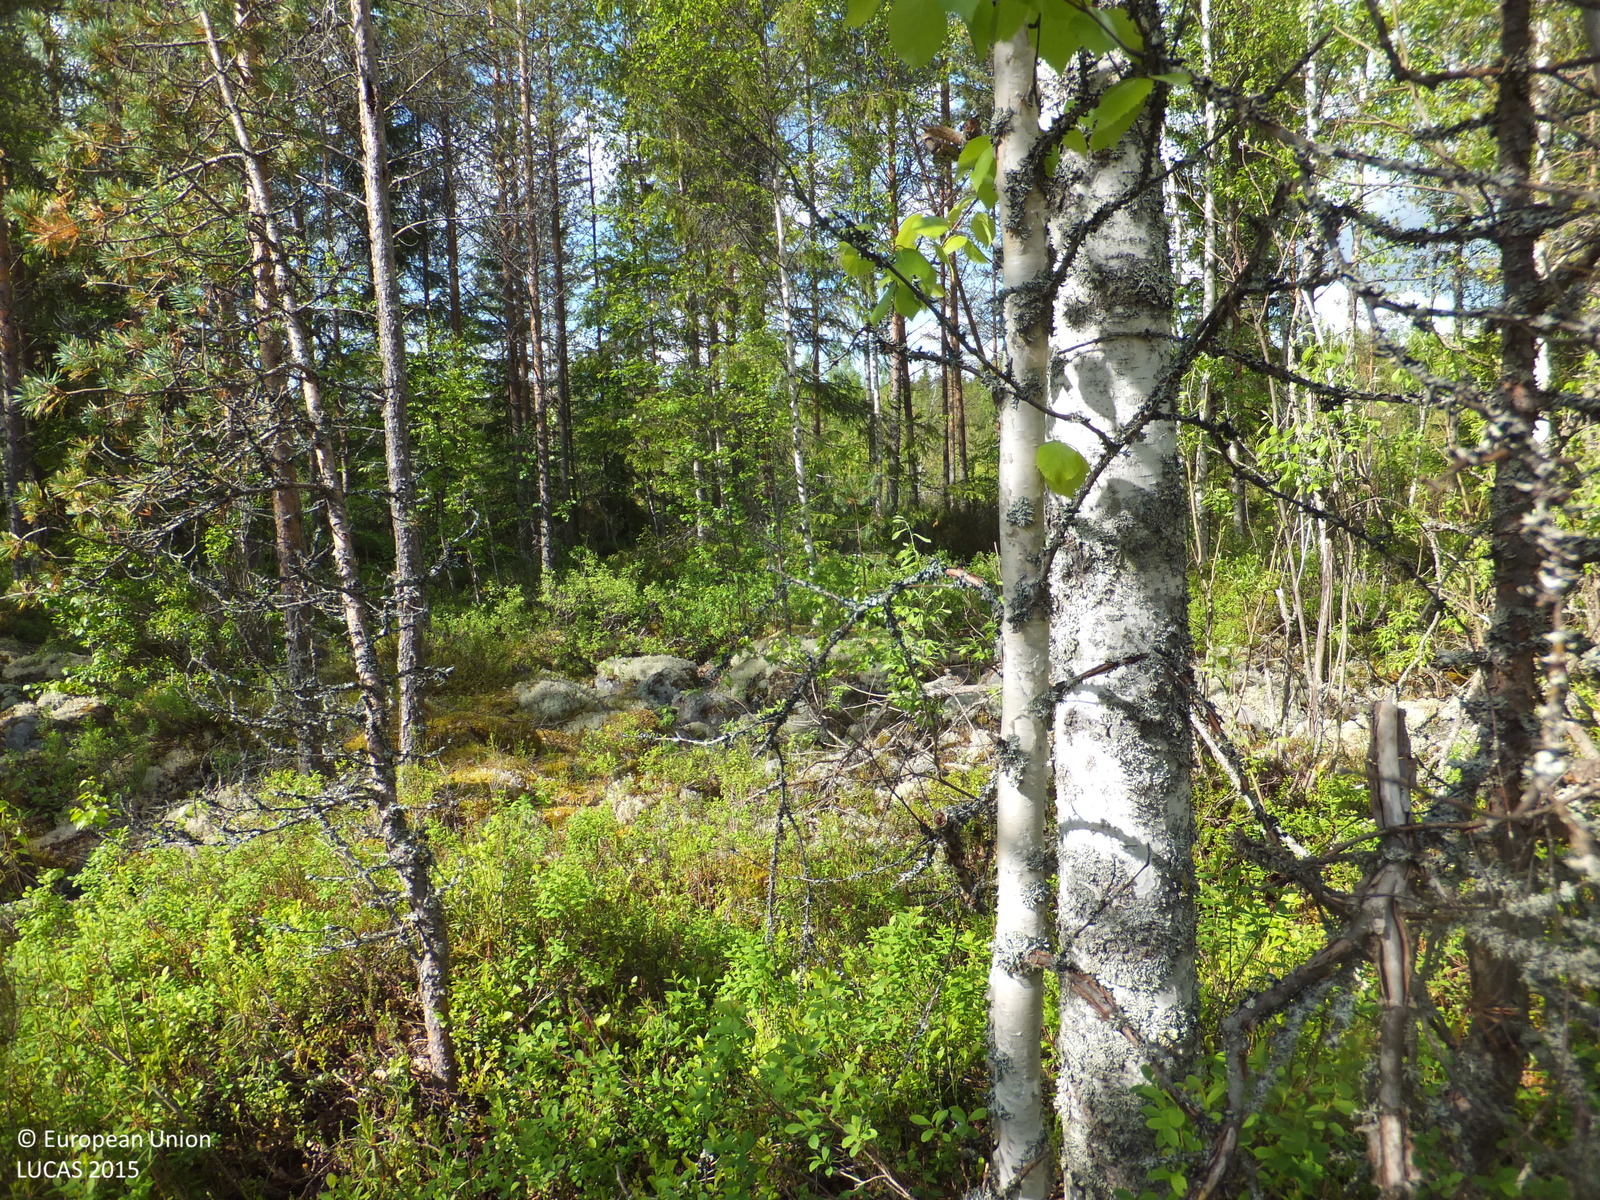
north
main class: Woodland
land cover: Broadleaved woodland
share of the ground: 50 - 75 %
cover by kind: broadleaved forest trees 50 %, shrubs 20 %, lichens and mosses 15 %, coniferous forest trees 10 %, consolidated bare surface 5 %
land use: Forestry
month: June
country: FI
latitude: 63.6983
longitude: 24.9961
